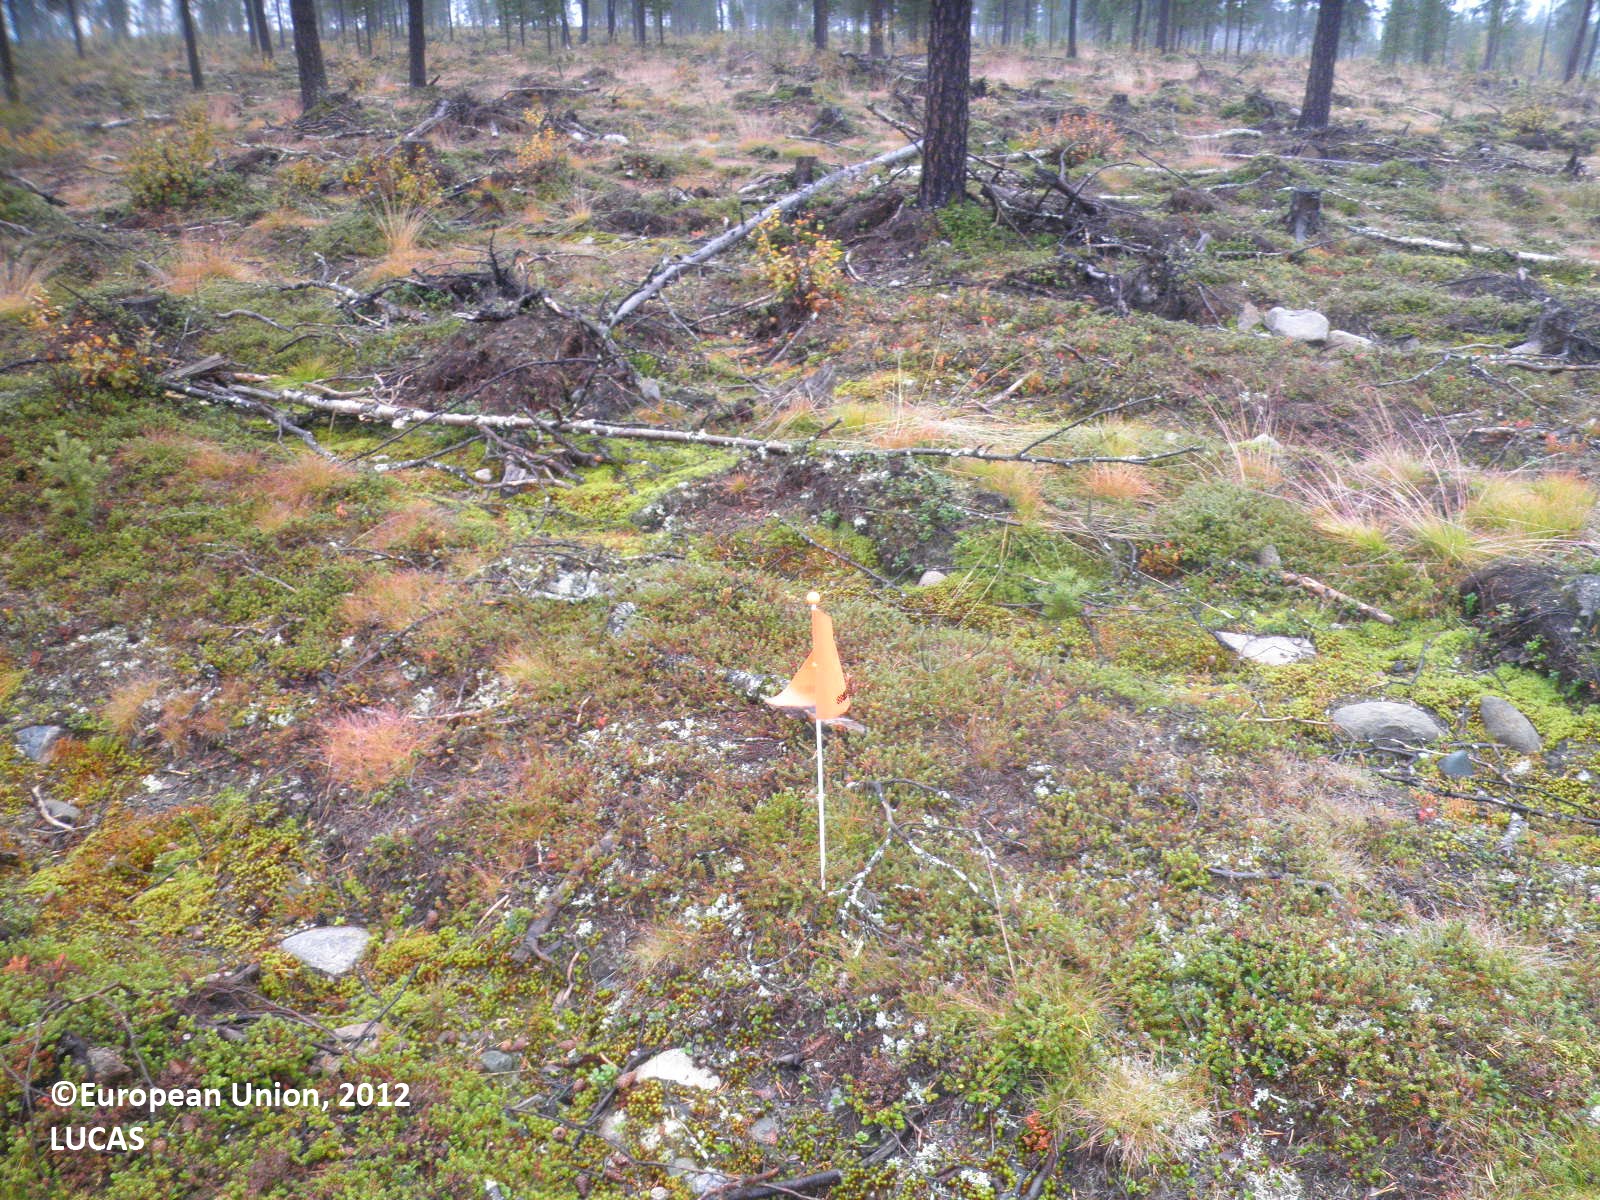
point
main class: Woodland
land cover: Pine dominated coniferous woodland
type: boreal forest
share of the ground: 10 - 25 %
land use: Forestry
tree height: > 5 m
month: September
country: FI
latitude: 68.4387
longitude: 22.7965
